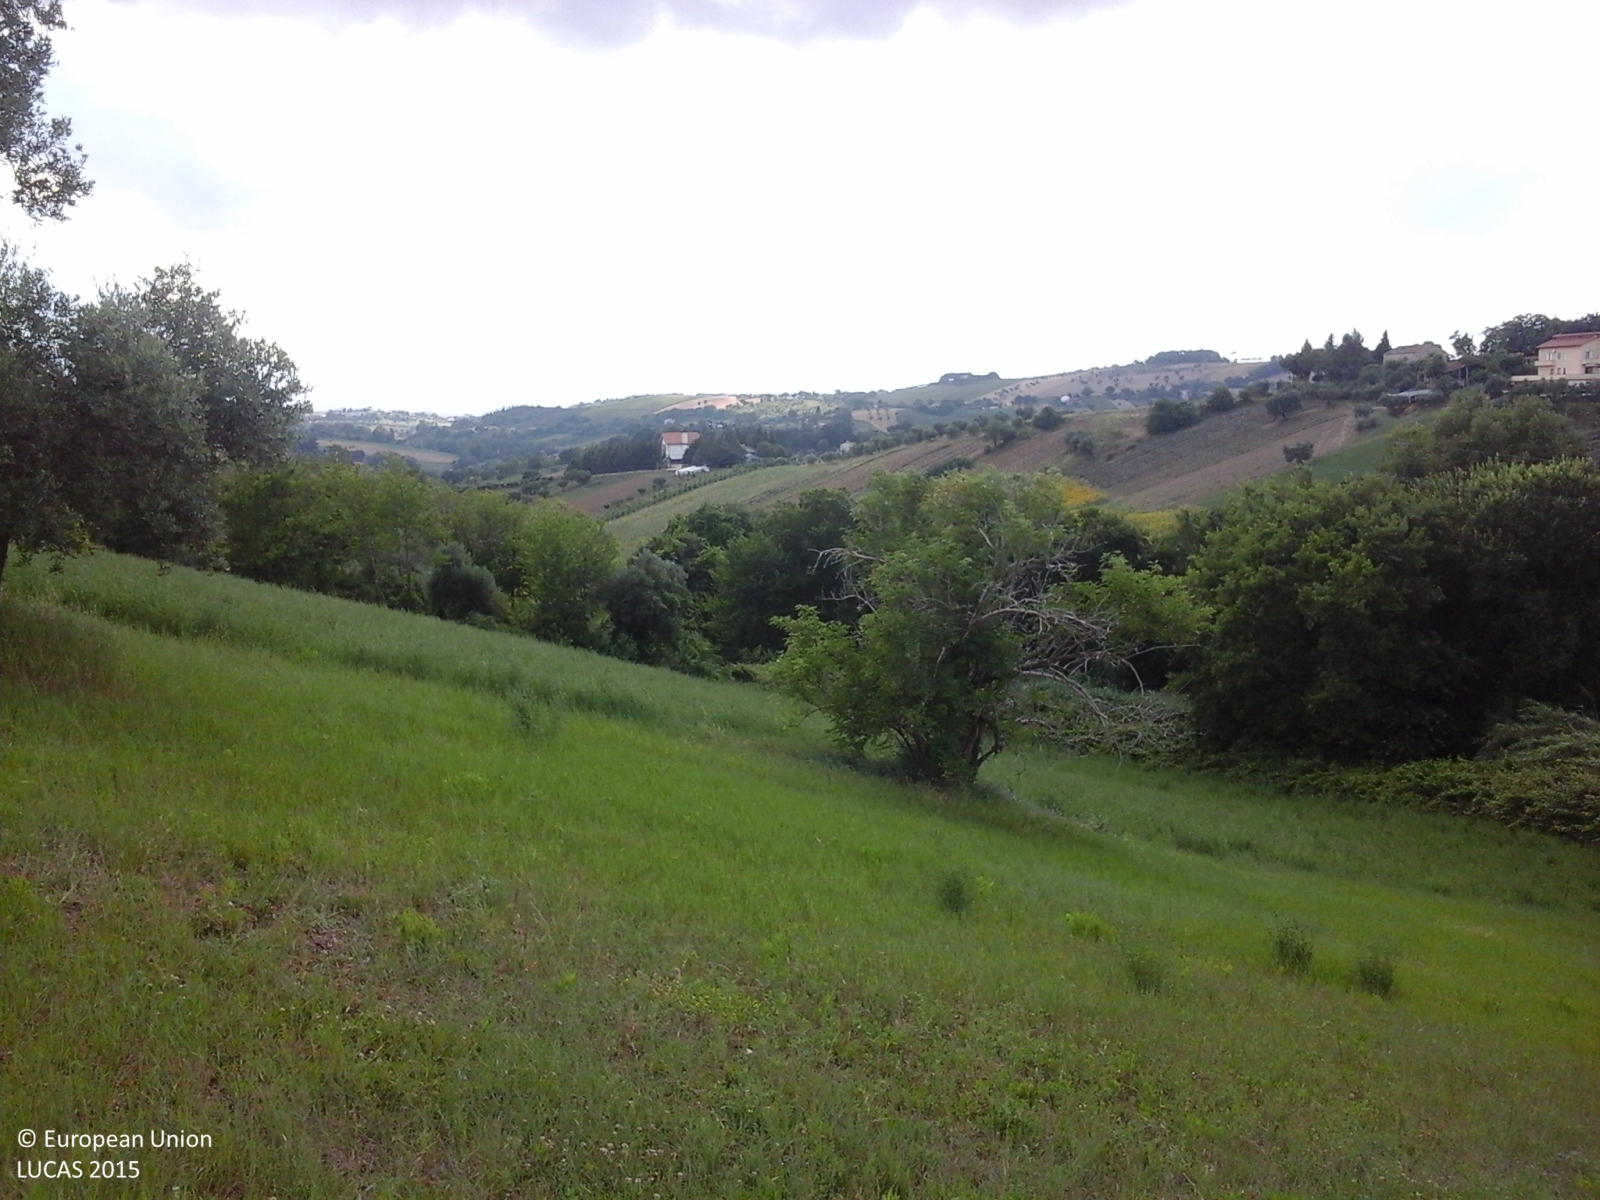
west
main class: Grassland
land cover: Grassland without tree/shrub cover
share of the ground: > 75 %
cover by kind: herbaceous plants 100 %
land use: Agriculture (excluding fallow land and kitchen gardens)
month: June
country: IT
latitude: 43.3171
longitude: 13.4806
